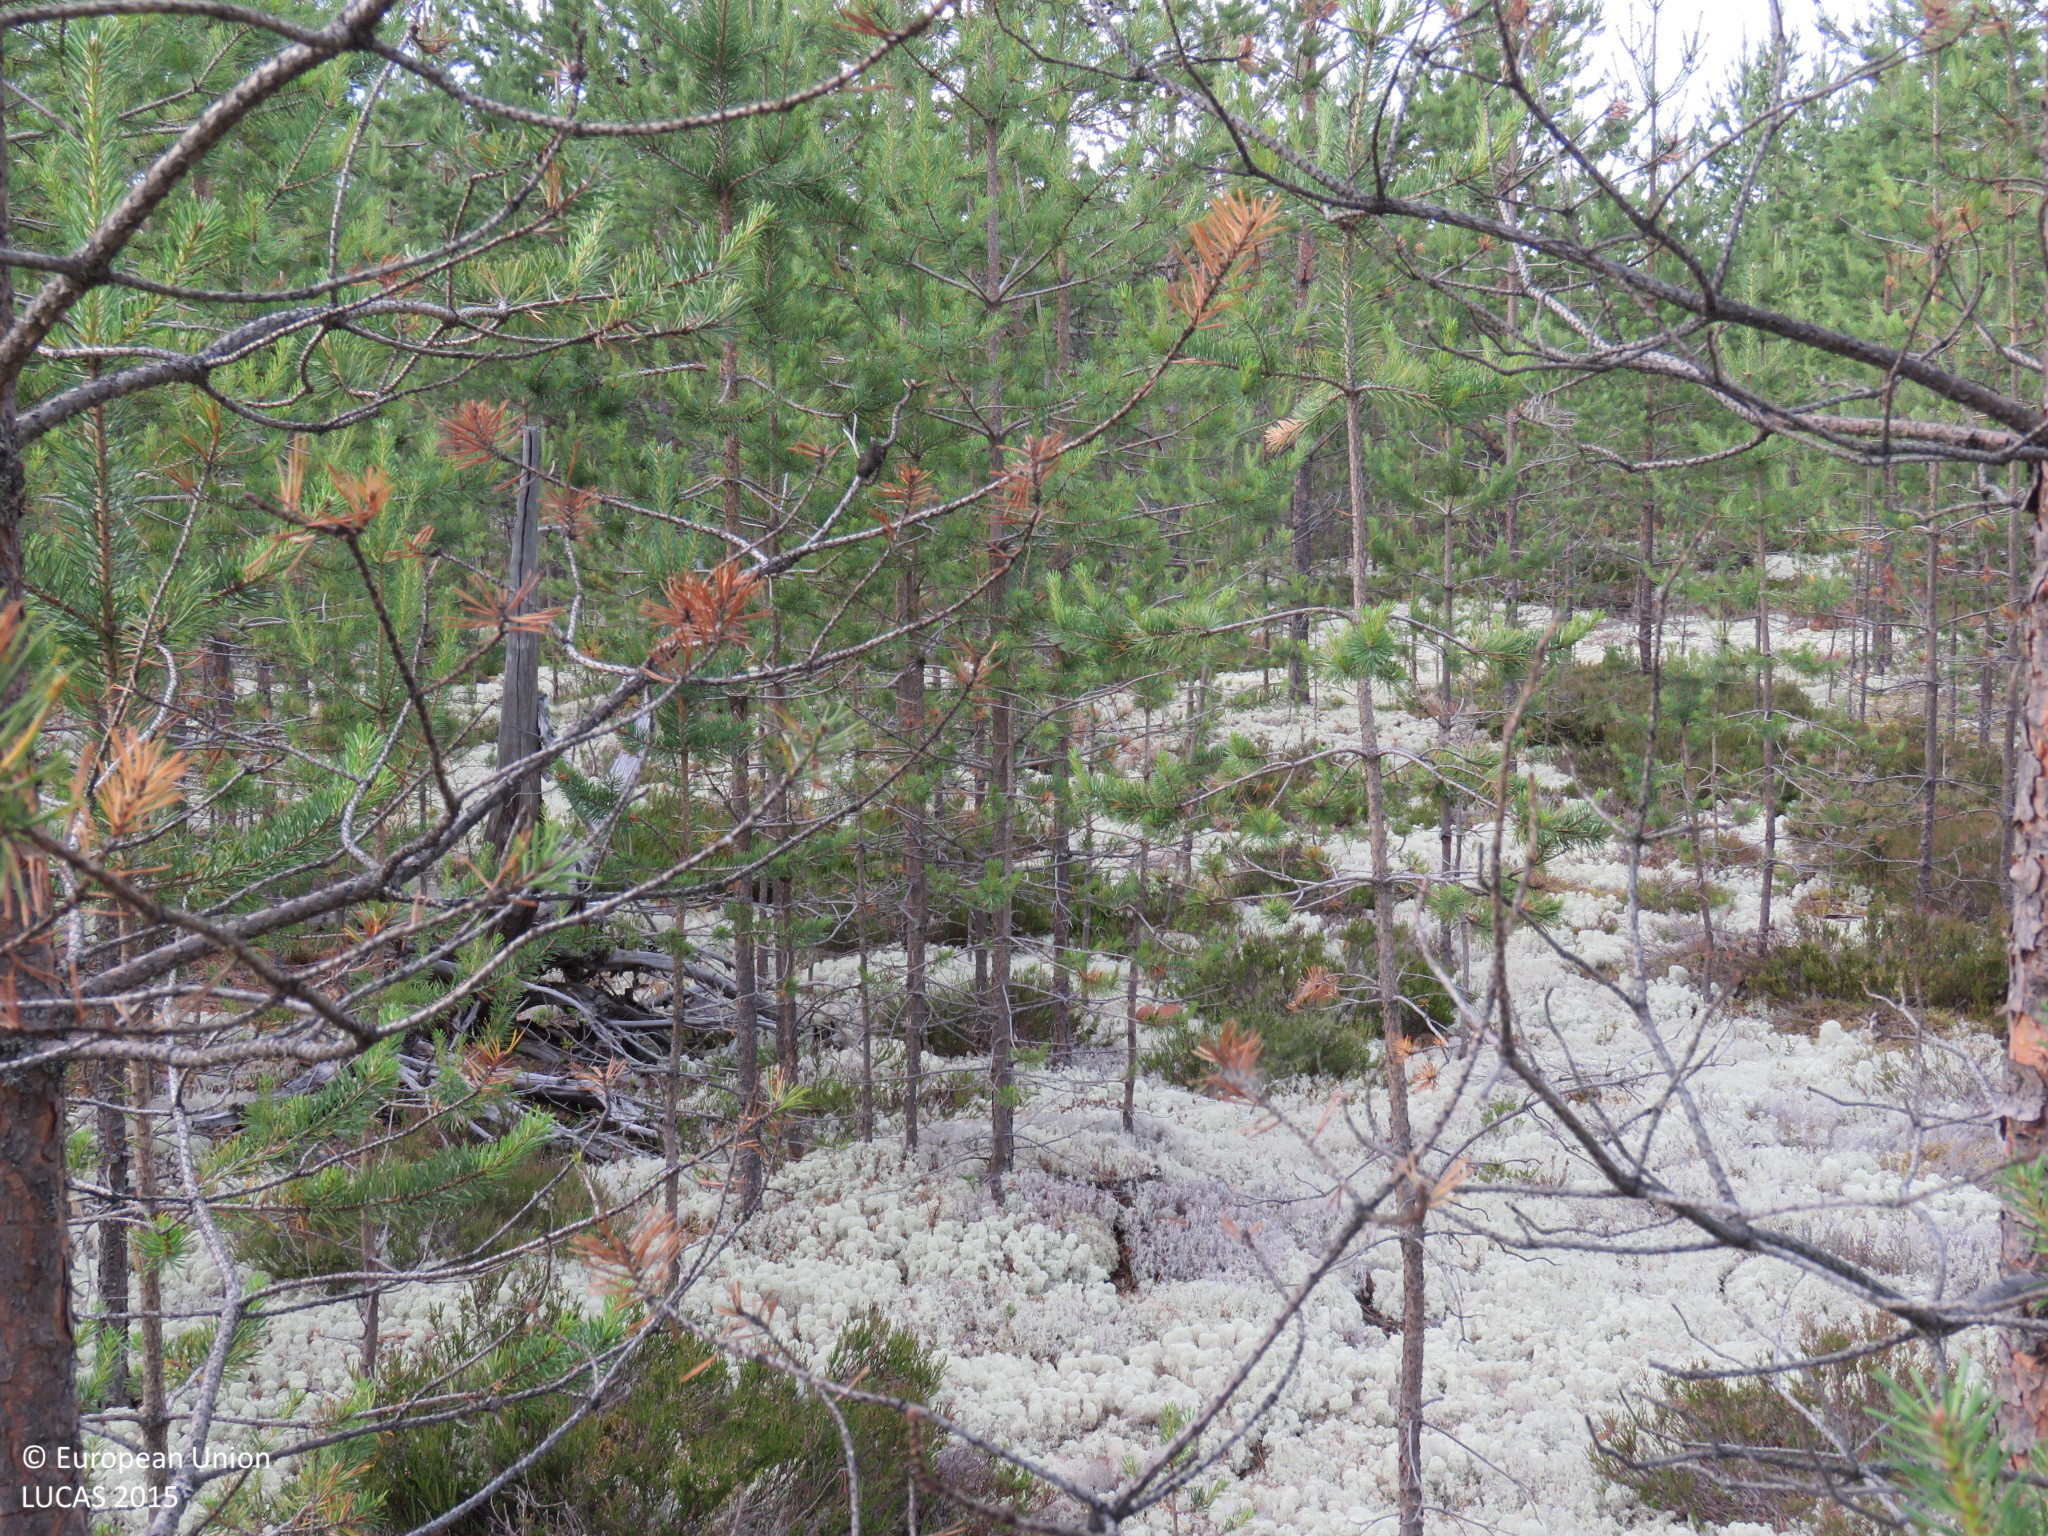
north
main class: Woodland
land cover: Pine dominated coniferous woodland
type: boreal forest
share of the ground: > 75 %
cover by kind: coniferous forest trees 75 %, lichens and mosses 20 %, shrubs 5 %
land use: Forestry
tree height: > 5 m
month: July
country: FI
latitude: 64.6077
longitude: 26.4350
